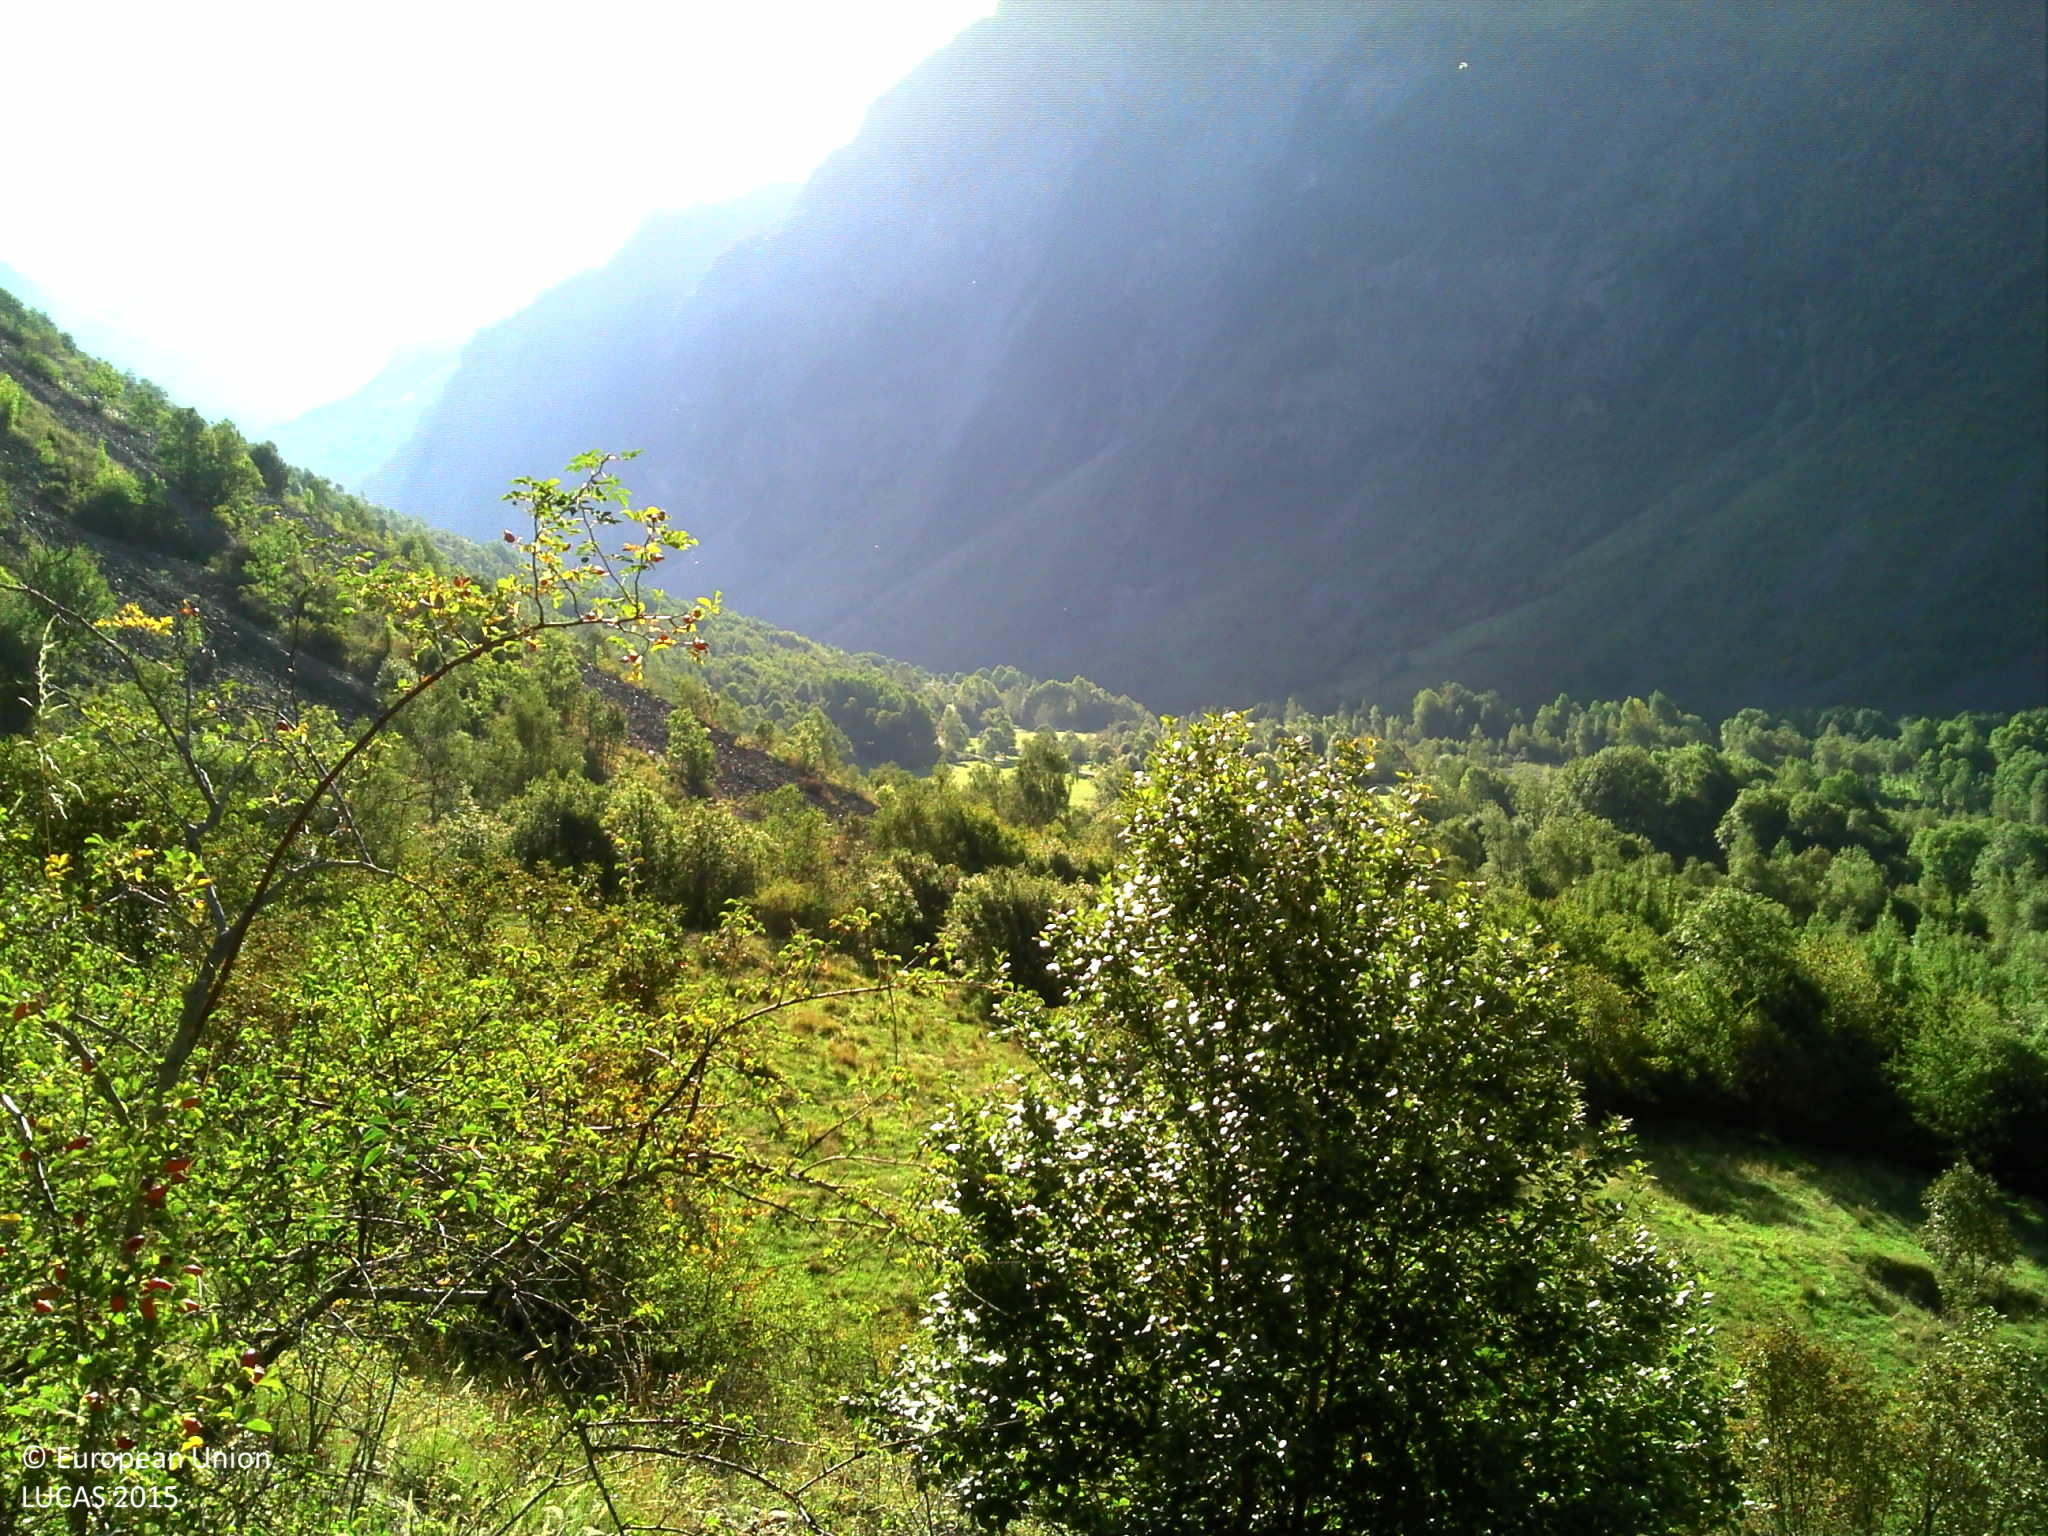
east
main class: Shrubland
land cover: Shrubland with sparse tree cover
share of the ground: > 75 %
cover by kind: consolidated bare surface 60 %, herbaceous plants 20 %, shrubs 15 %, broadleaved forest trees 5 %
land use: Semi-natural and natural areas not in use
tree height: > 5 m
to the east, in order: Shrubland with sparse tree cover; Broadleaved woodland; Grassland with sparse tree/shrub cover; Broadleaved woodland; Inland fresh running water; Broadleaved woodland; Tracks; Broadleaved woodland; Shrubland with sparse tree cover; Broadleaved woodland; Tracks; Shrubland with sparse tree cover; Rocks and stones
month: August
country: FR
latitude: 44.8225
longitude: 6.1993
